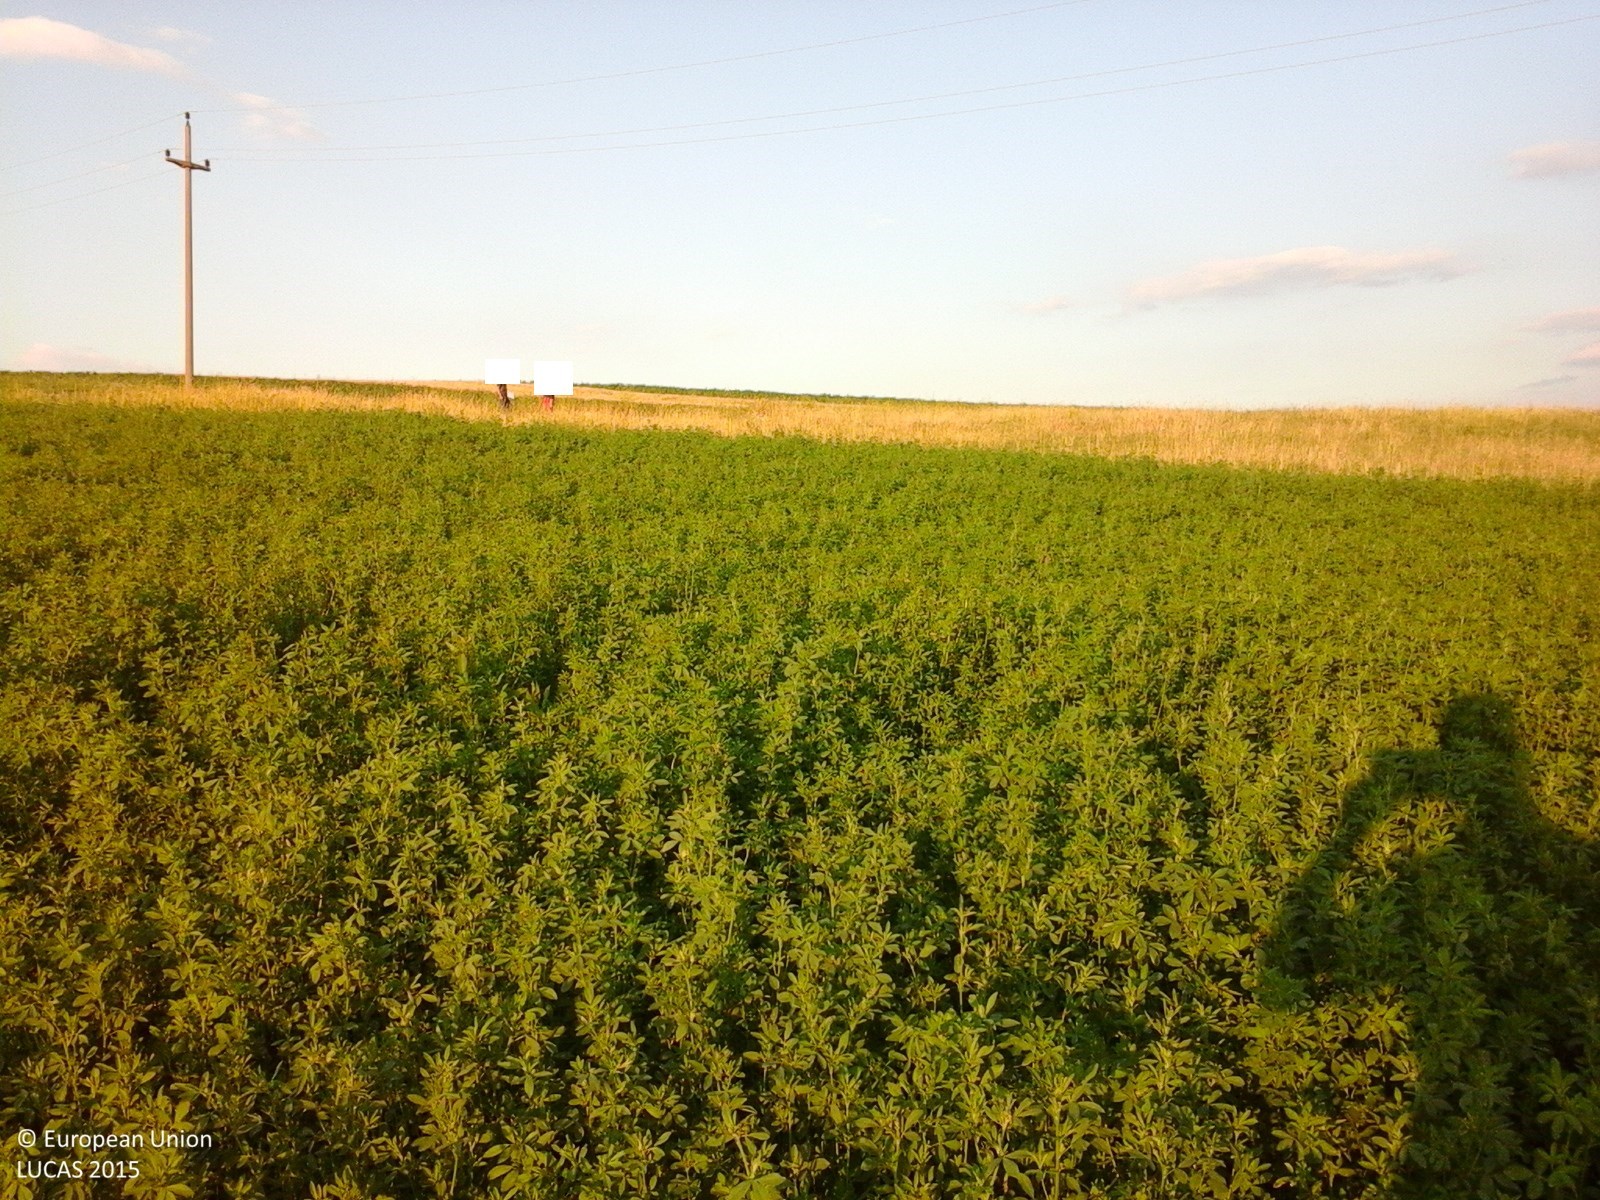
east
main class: Cropland
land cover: Lucerne
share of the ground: > 75 %
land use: Agriculture (excluding fallow land and kitchen gardens)
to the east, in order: Lucerne; Electric lines; Grassland without tree/shrub cover; Maize; Rye; Maize; Lucerne; Rye; Barley
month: June
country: RO
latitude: 47.5117
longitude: 26.4325
